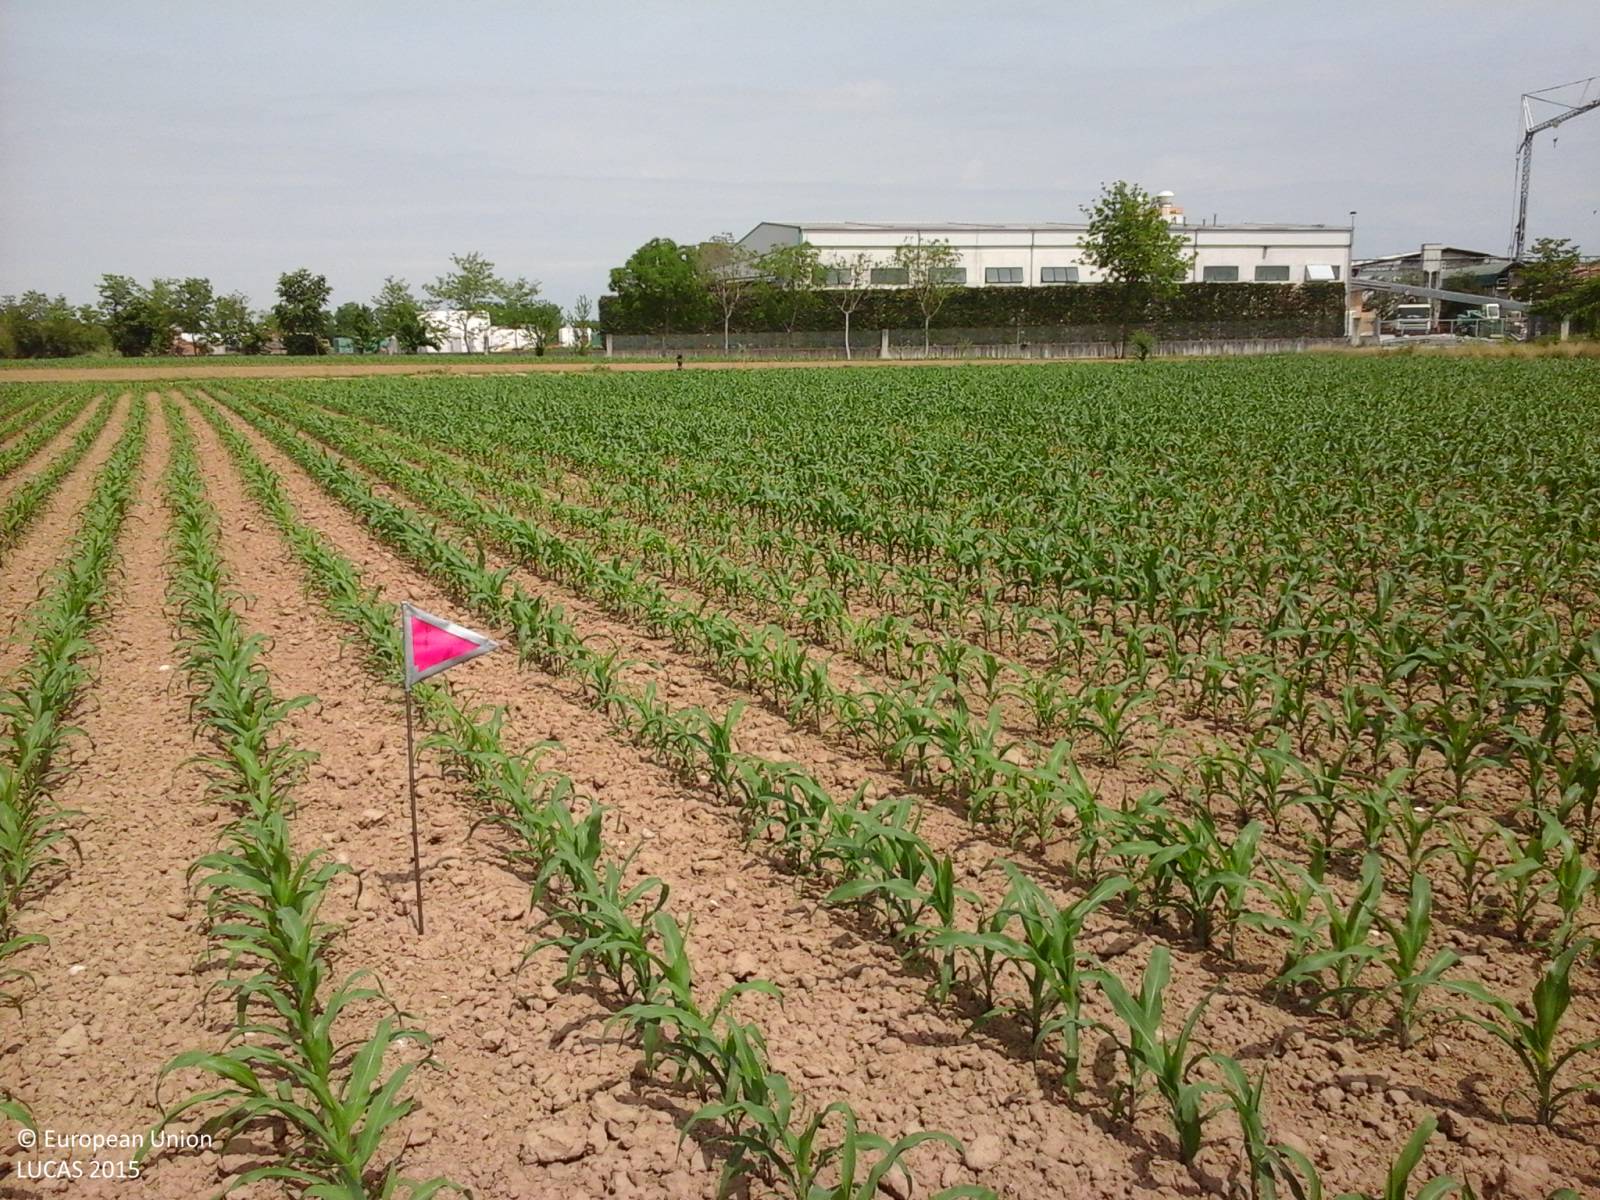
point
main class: Cropland
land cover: Maize
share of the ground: 25 - 50 %
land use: Agriculture (excluding fallow land and kitchen gardens)
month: May
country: IT
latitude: 45.9754
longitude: 13.3133
